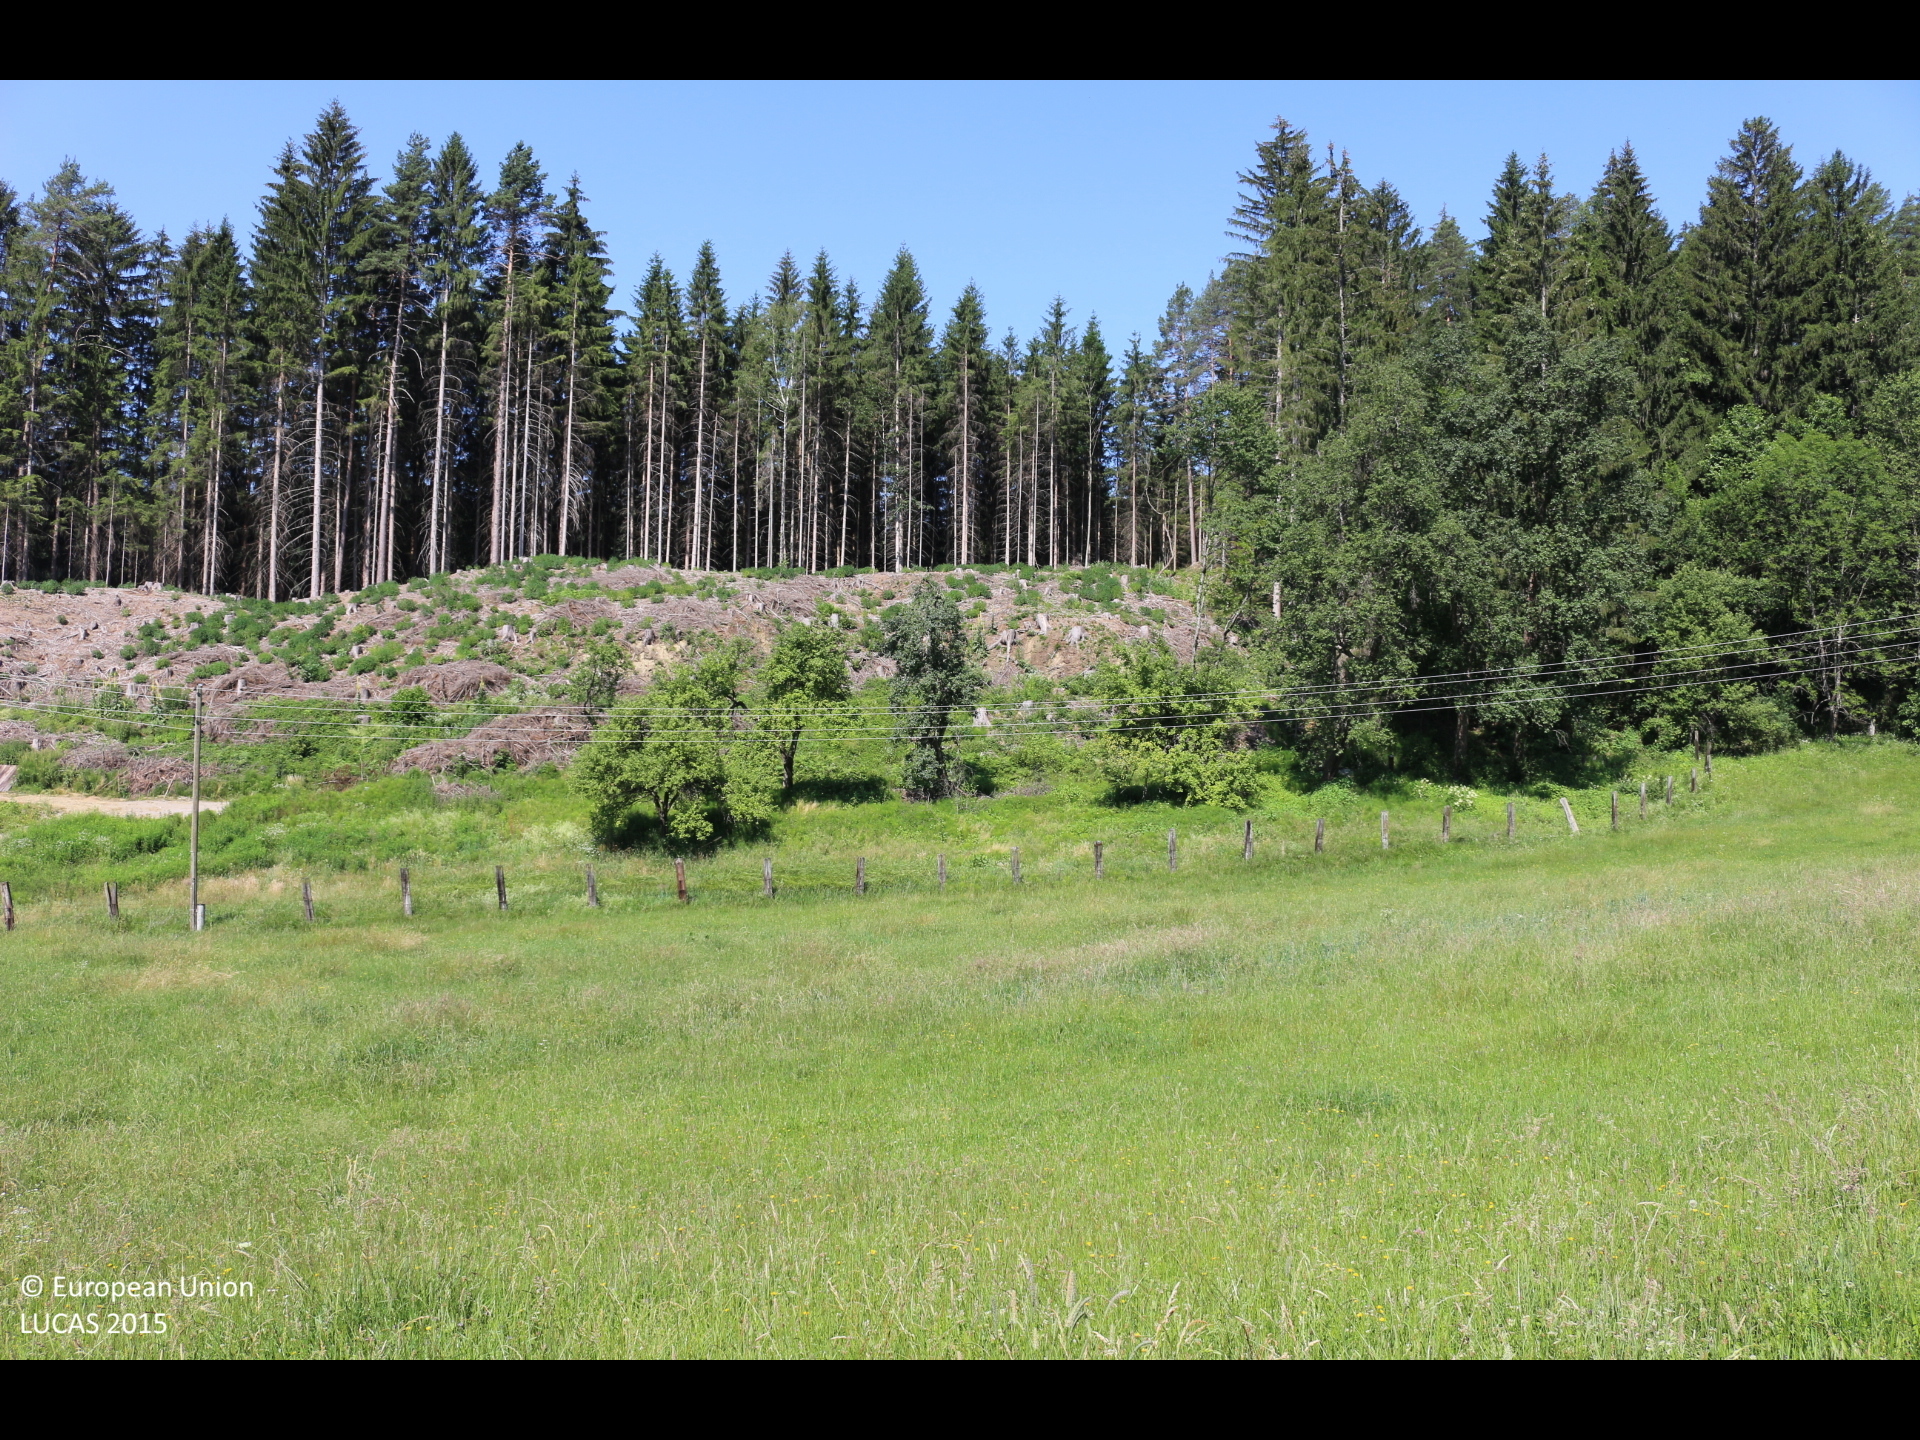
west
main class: Grassland
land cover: Grassland without tree/shrub cover
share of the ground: > 75 %
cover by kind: herbaceous plants 100 %
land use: Agriculture (excluding fallow land and kitchen gardens)
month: July
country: AT
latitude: 46.5984
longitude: 13.5608
